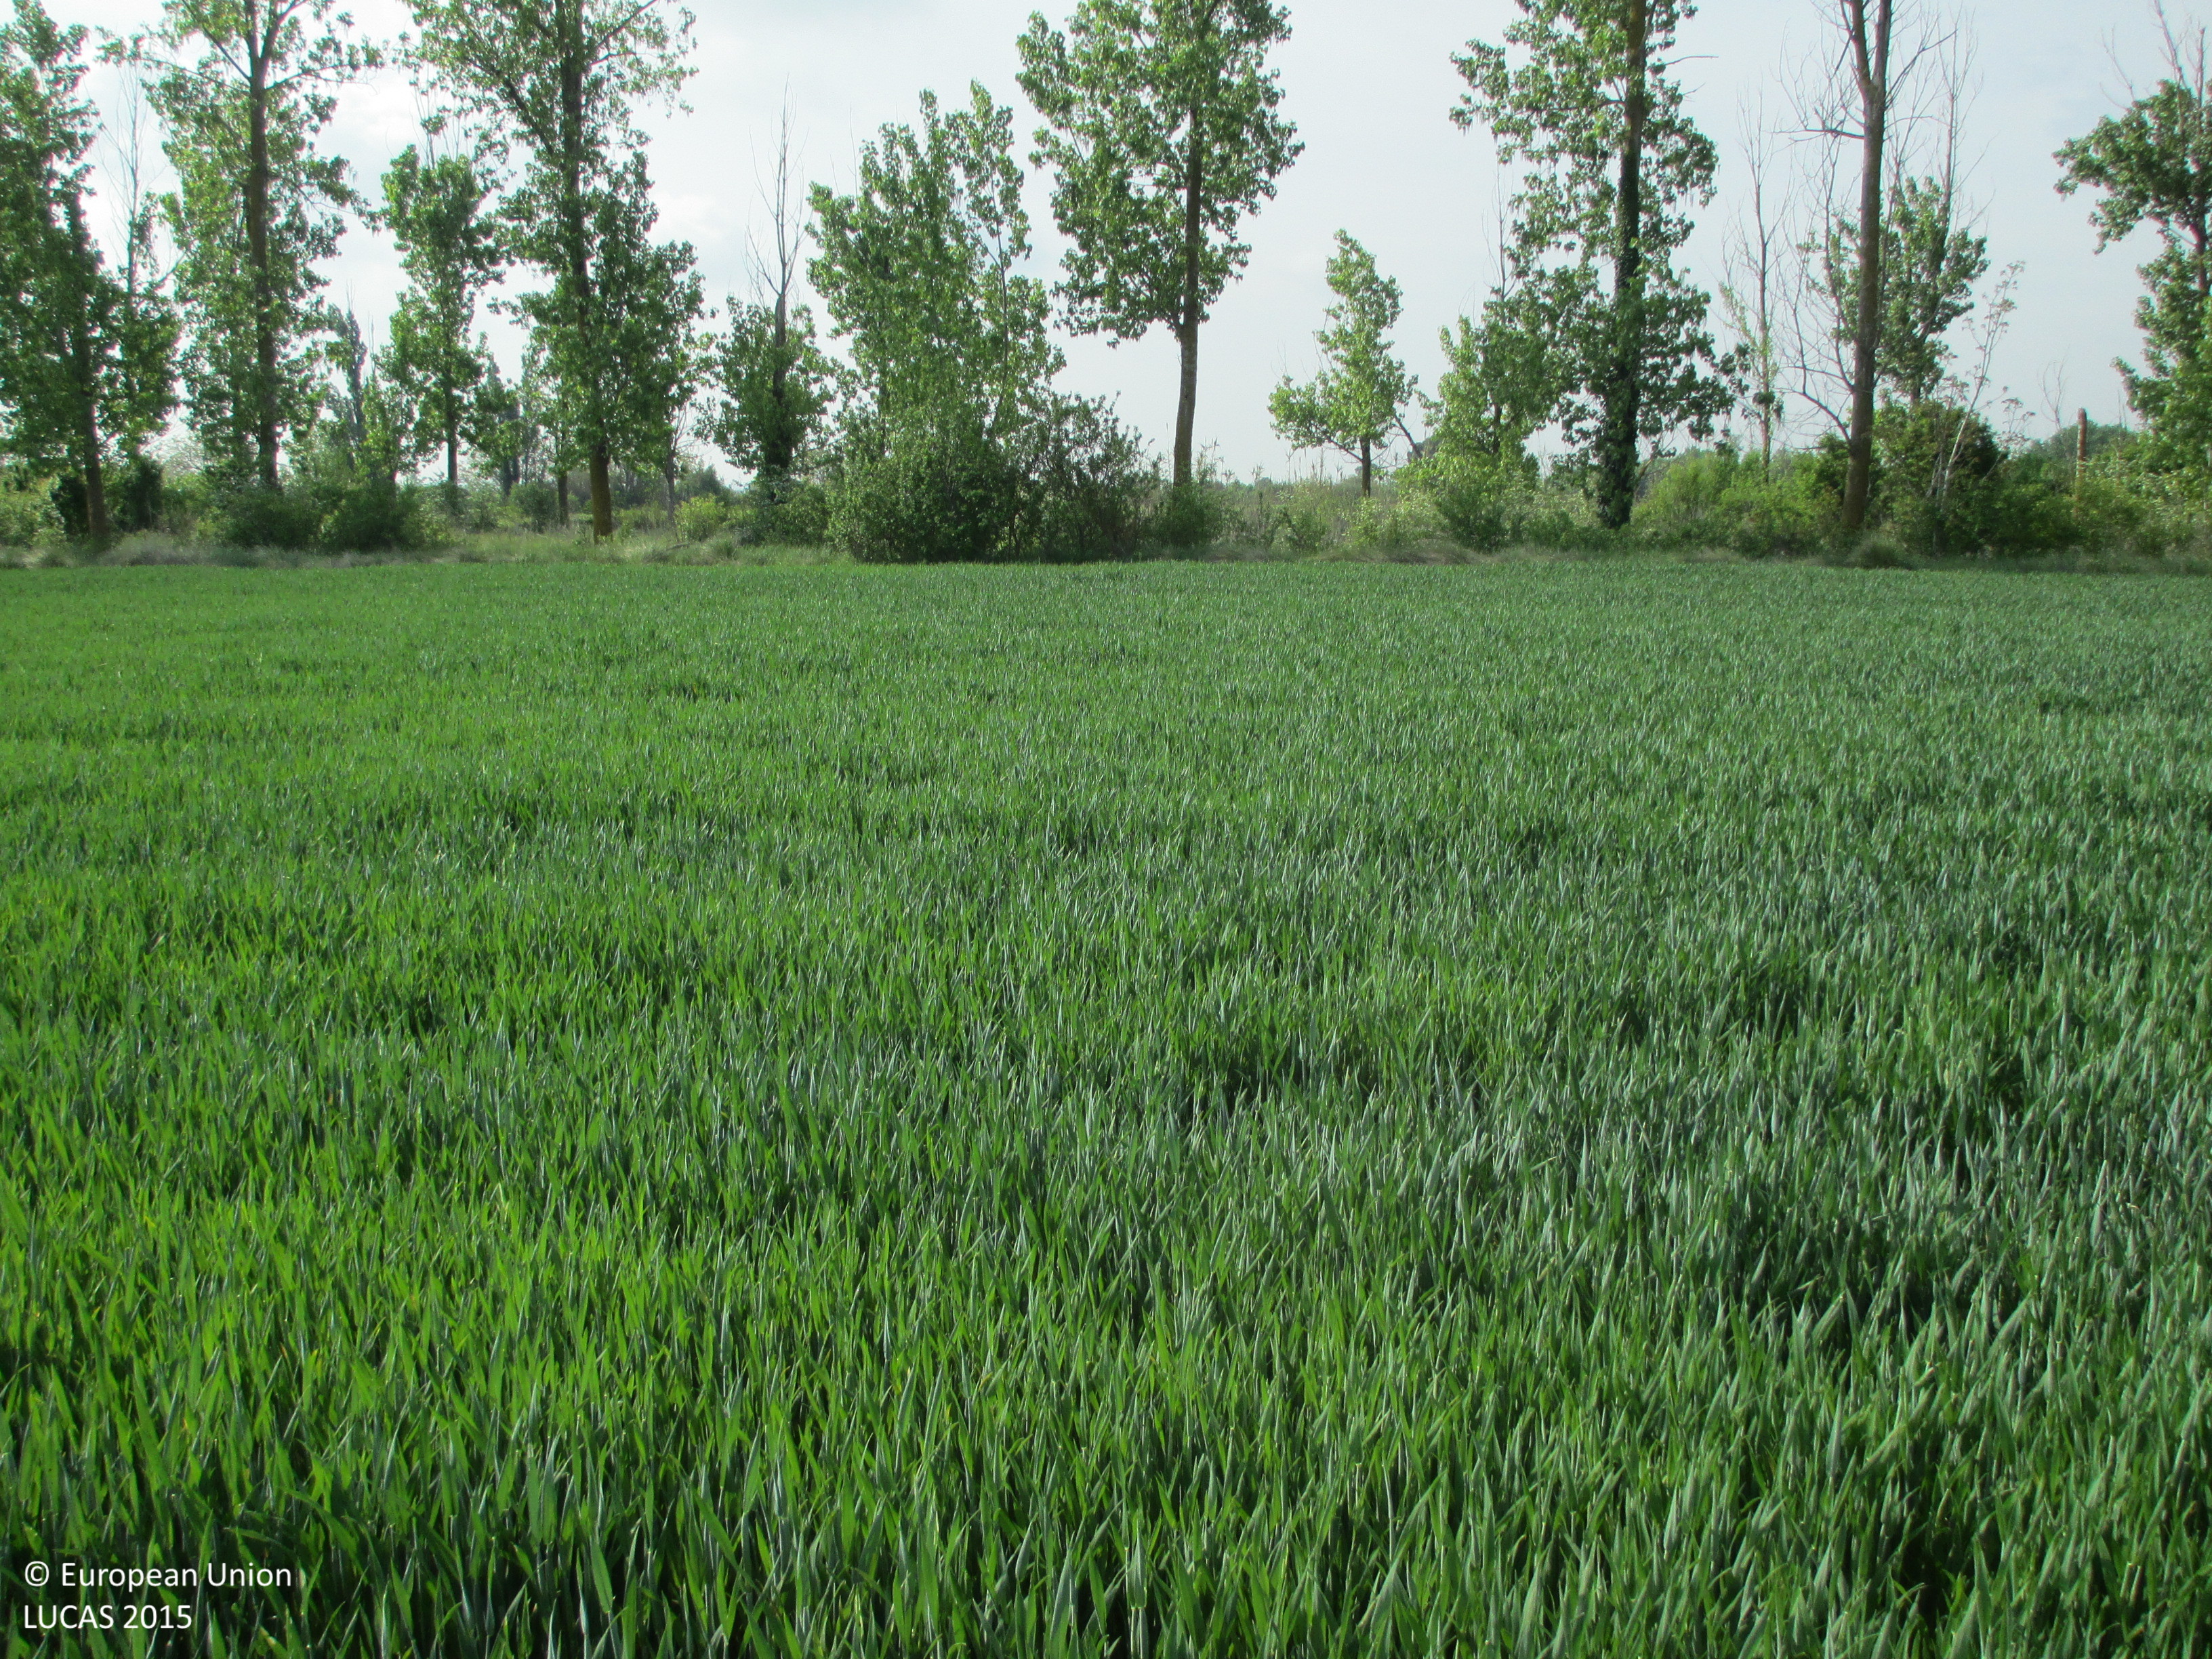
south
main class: Cropland
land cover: Durum wheat
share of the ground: > 75 %
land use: Agriculture (excluding fallow land and kitchen gardens)
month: April
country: ES
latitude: 42.1185
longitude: -0.3879
